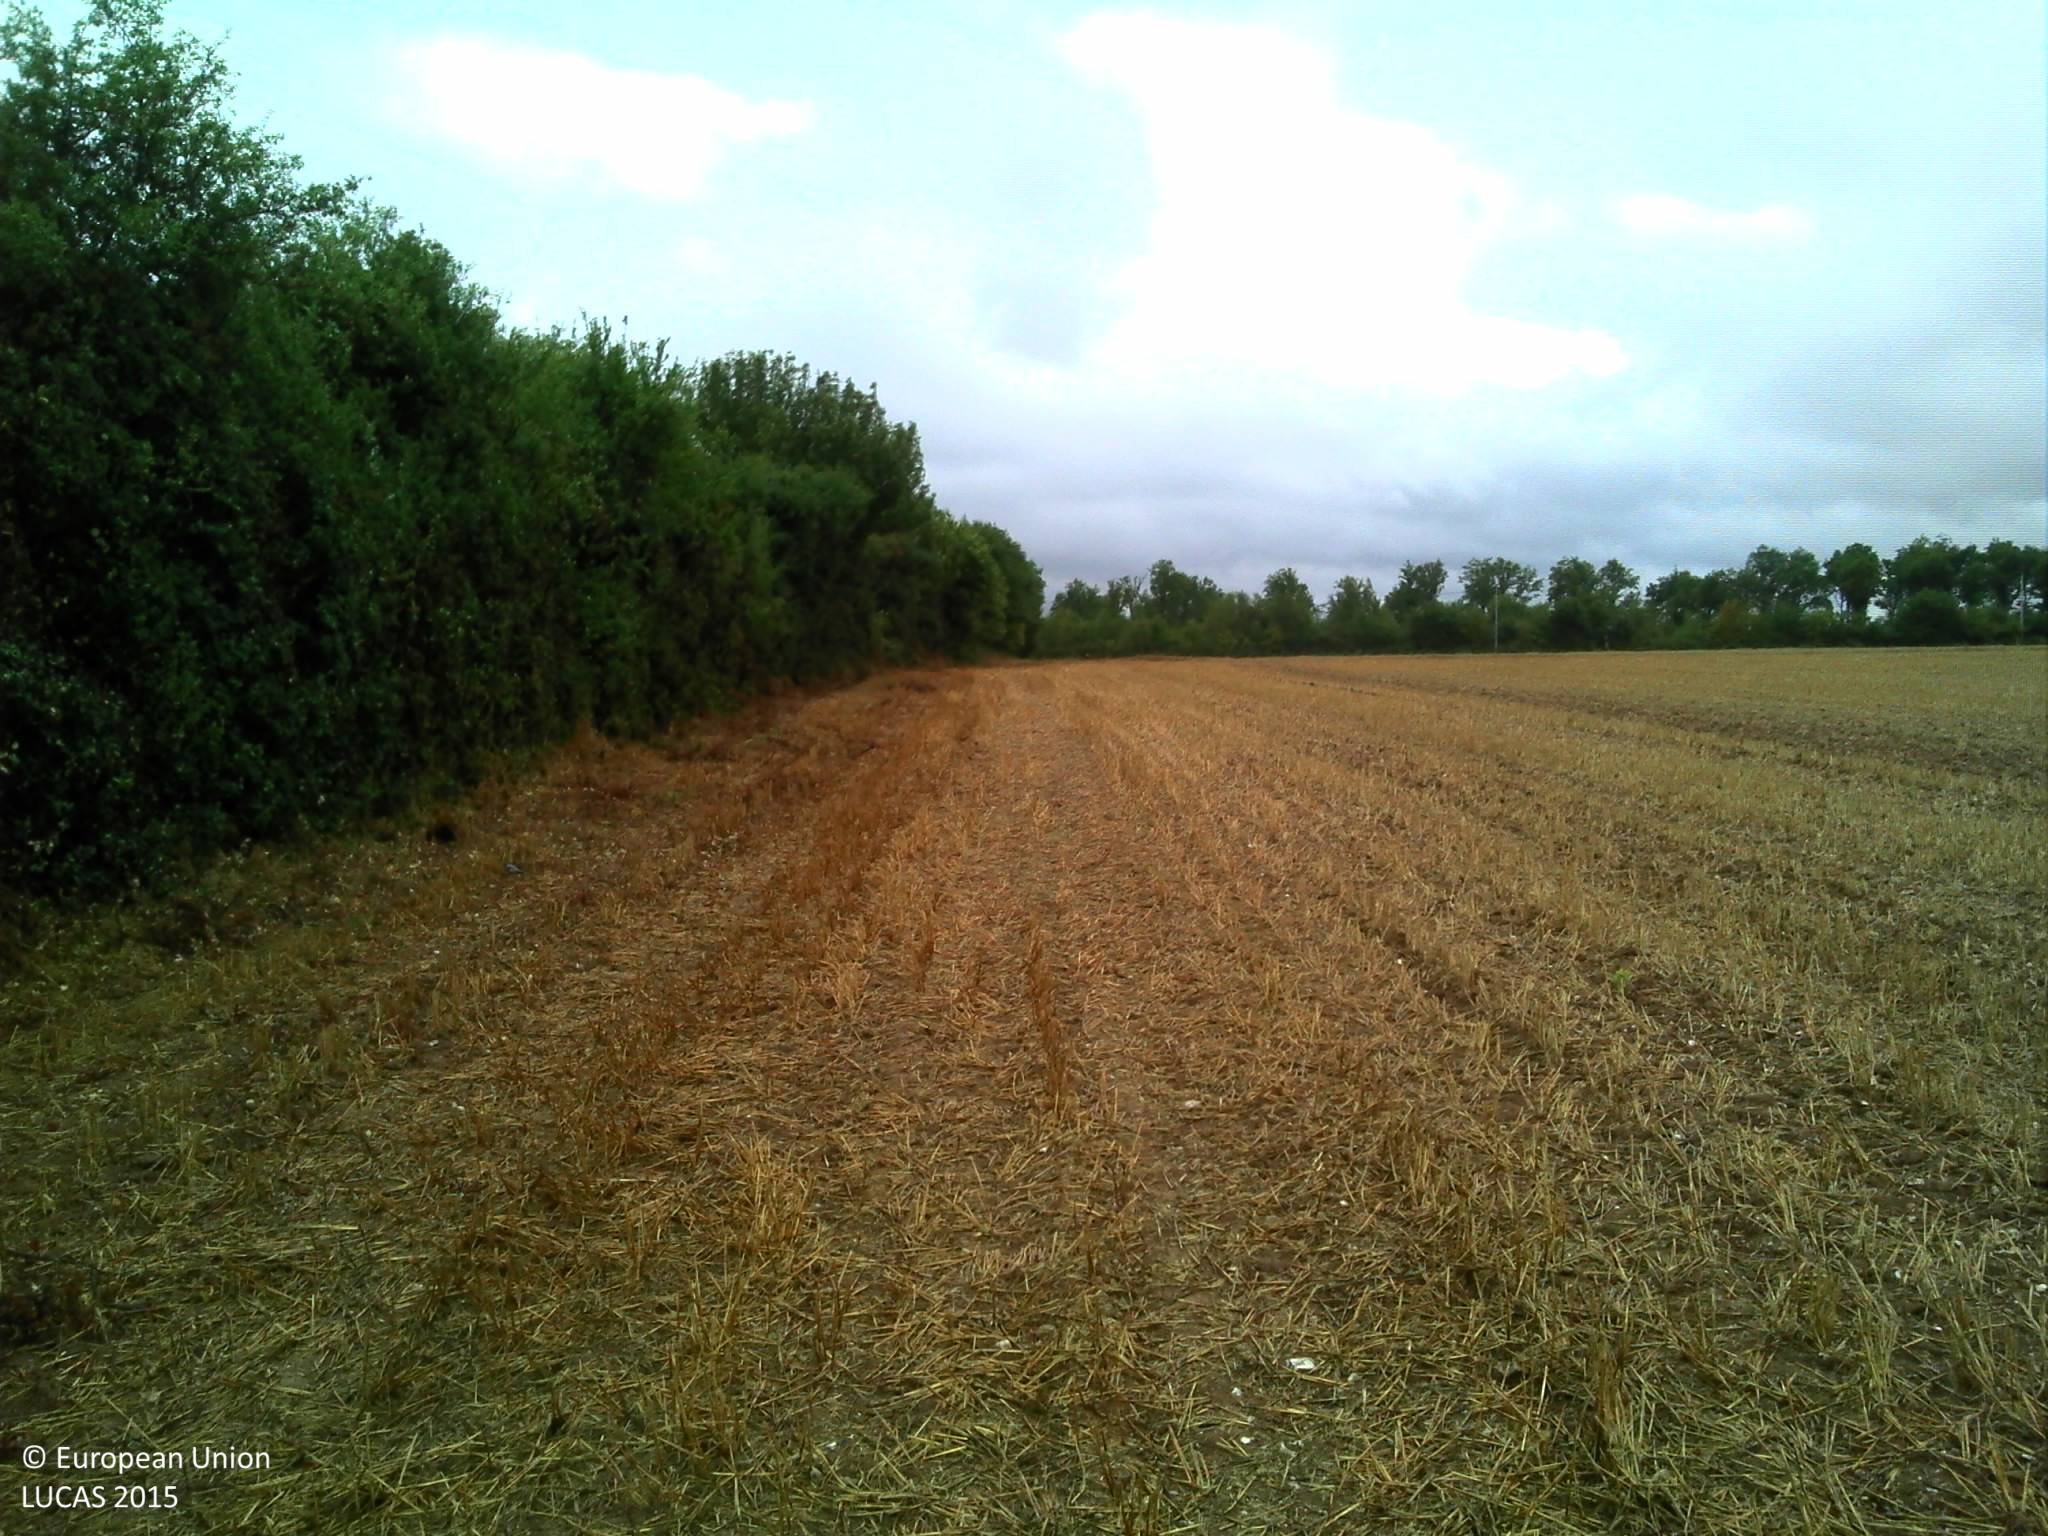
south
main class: Cropland
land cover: Common wheat
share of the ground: > 75 %
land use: Agriculture (excluding fallow land and kitchen gardens)
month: August
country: FR
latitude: 47.5346
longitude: -1.6148
